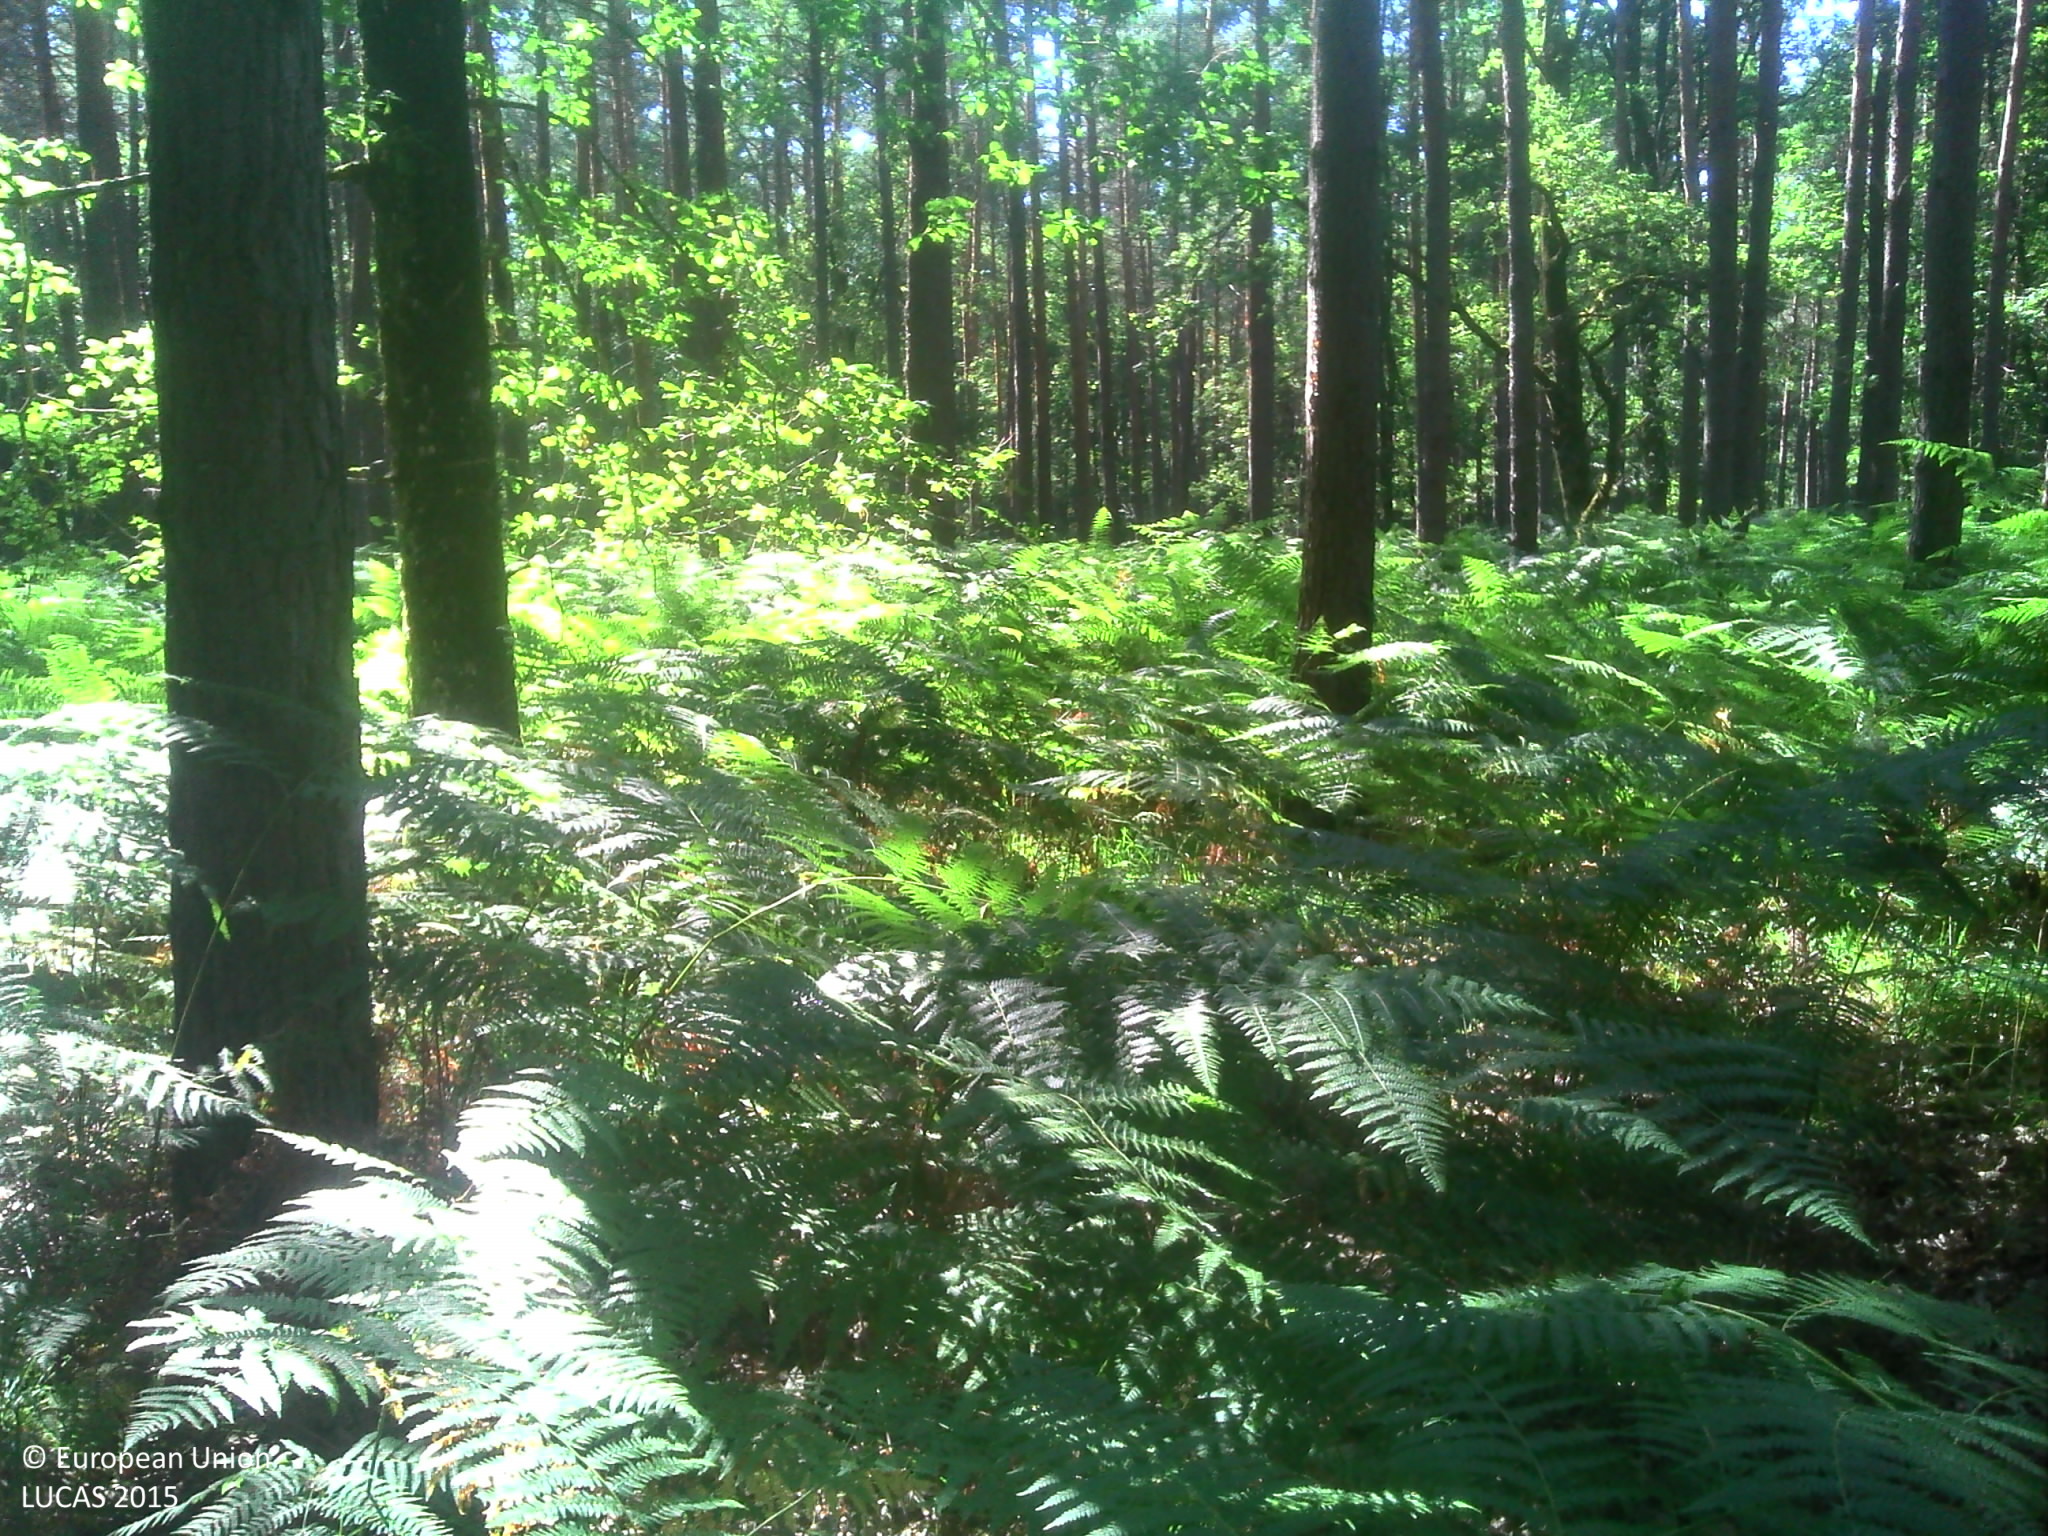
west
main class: Woodland
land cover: Pine dominated mixed woodland
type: thermophilous deciduous forest
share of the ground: > 75 %
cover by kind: herbaceous plants 40 %, unconsolidated bare surface 35 %, coniferous forest trees 15 %, broadleaved forest trees 10 %
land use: Forestry
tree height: > 5 m
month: June
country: FR
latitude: 47.3101
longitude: 1.4280
